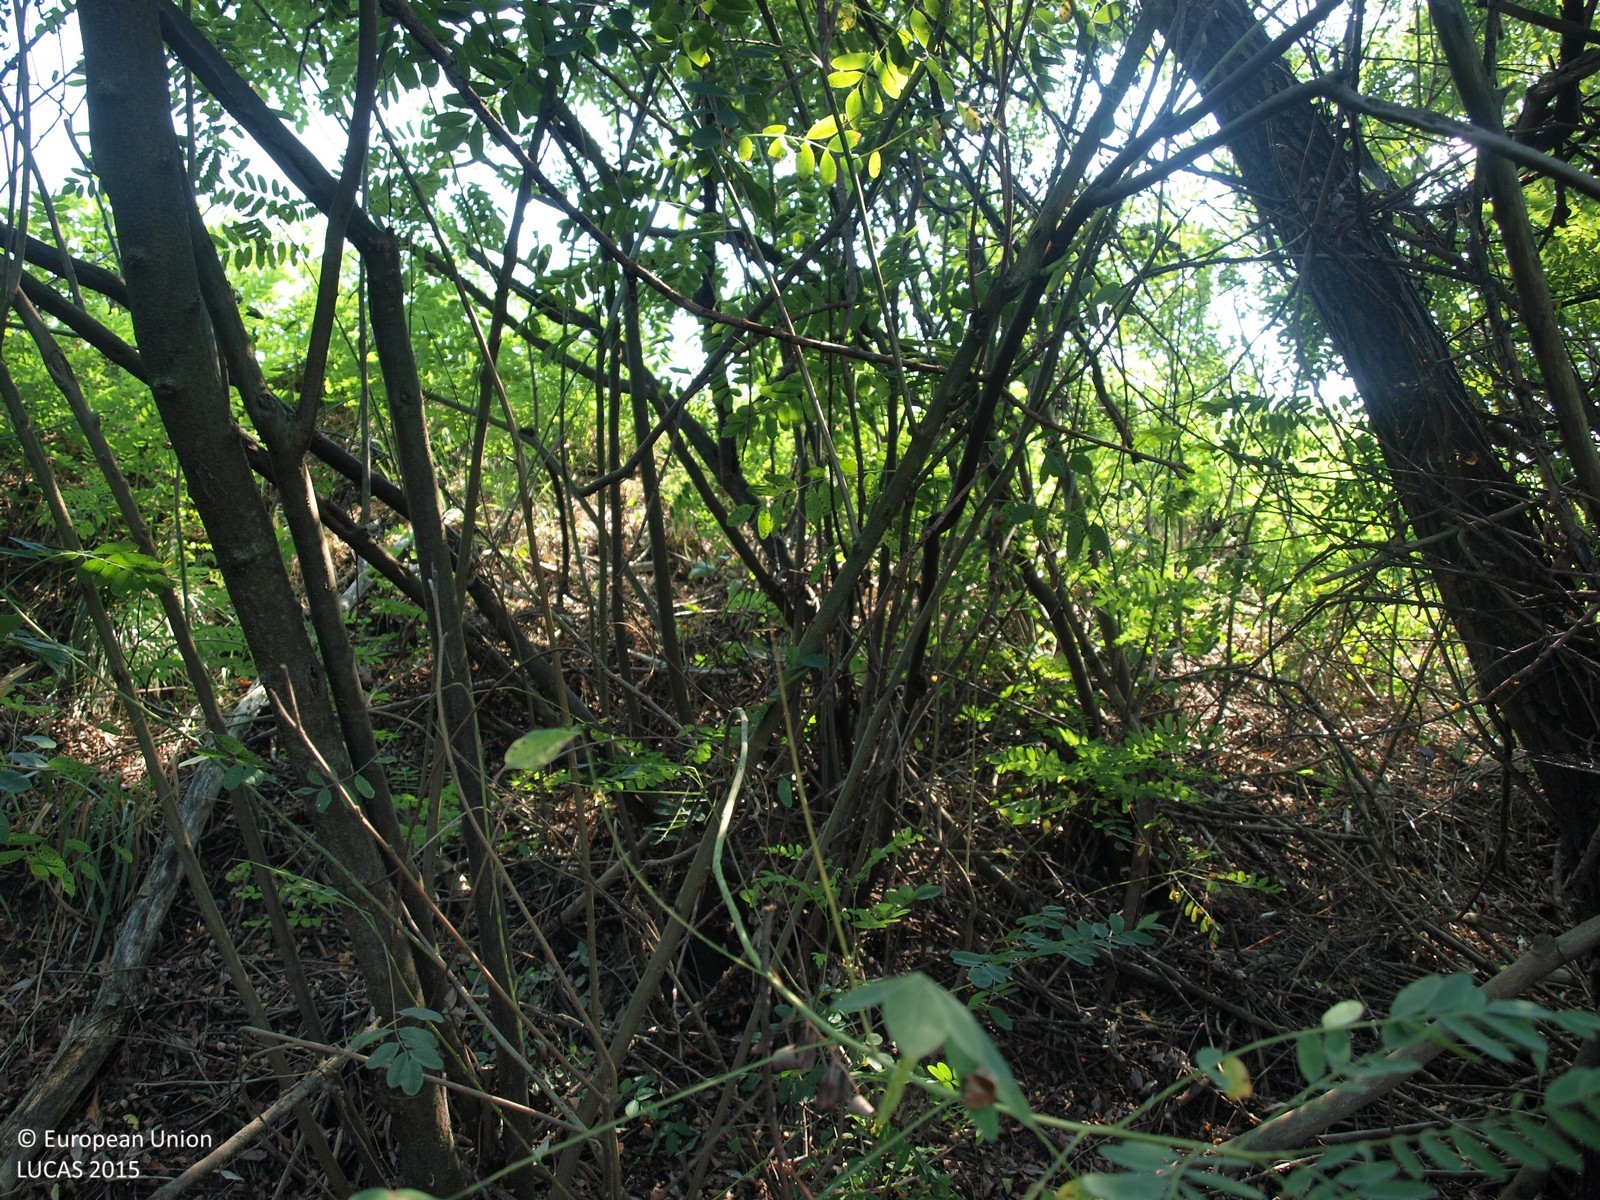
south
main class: Shrubland
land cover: Shrubland with sparse tree cover
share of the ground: > 75 %
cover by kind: shrubs 95 %, broadleaved forest trees 5 %
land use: Semi-natural and natural areas not in use
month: August
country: HR
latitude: 45.8149
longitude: 16.4209
